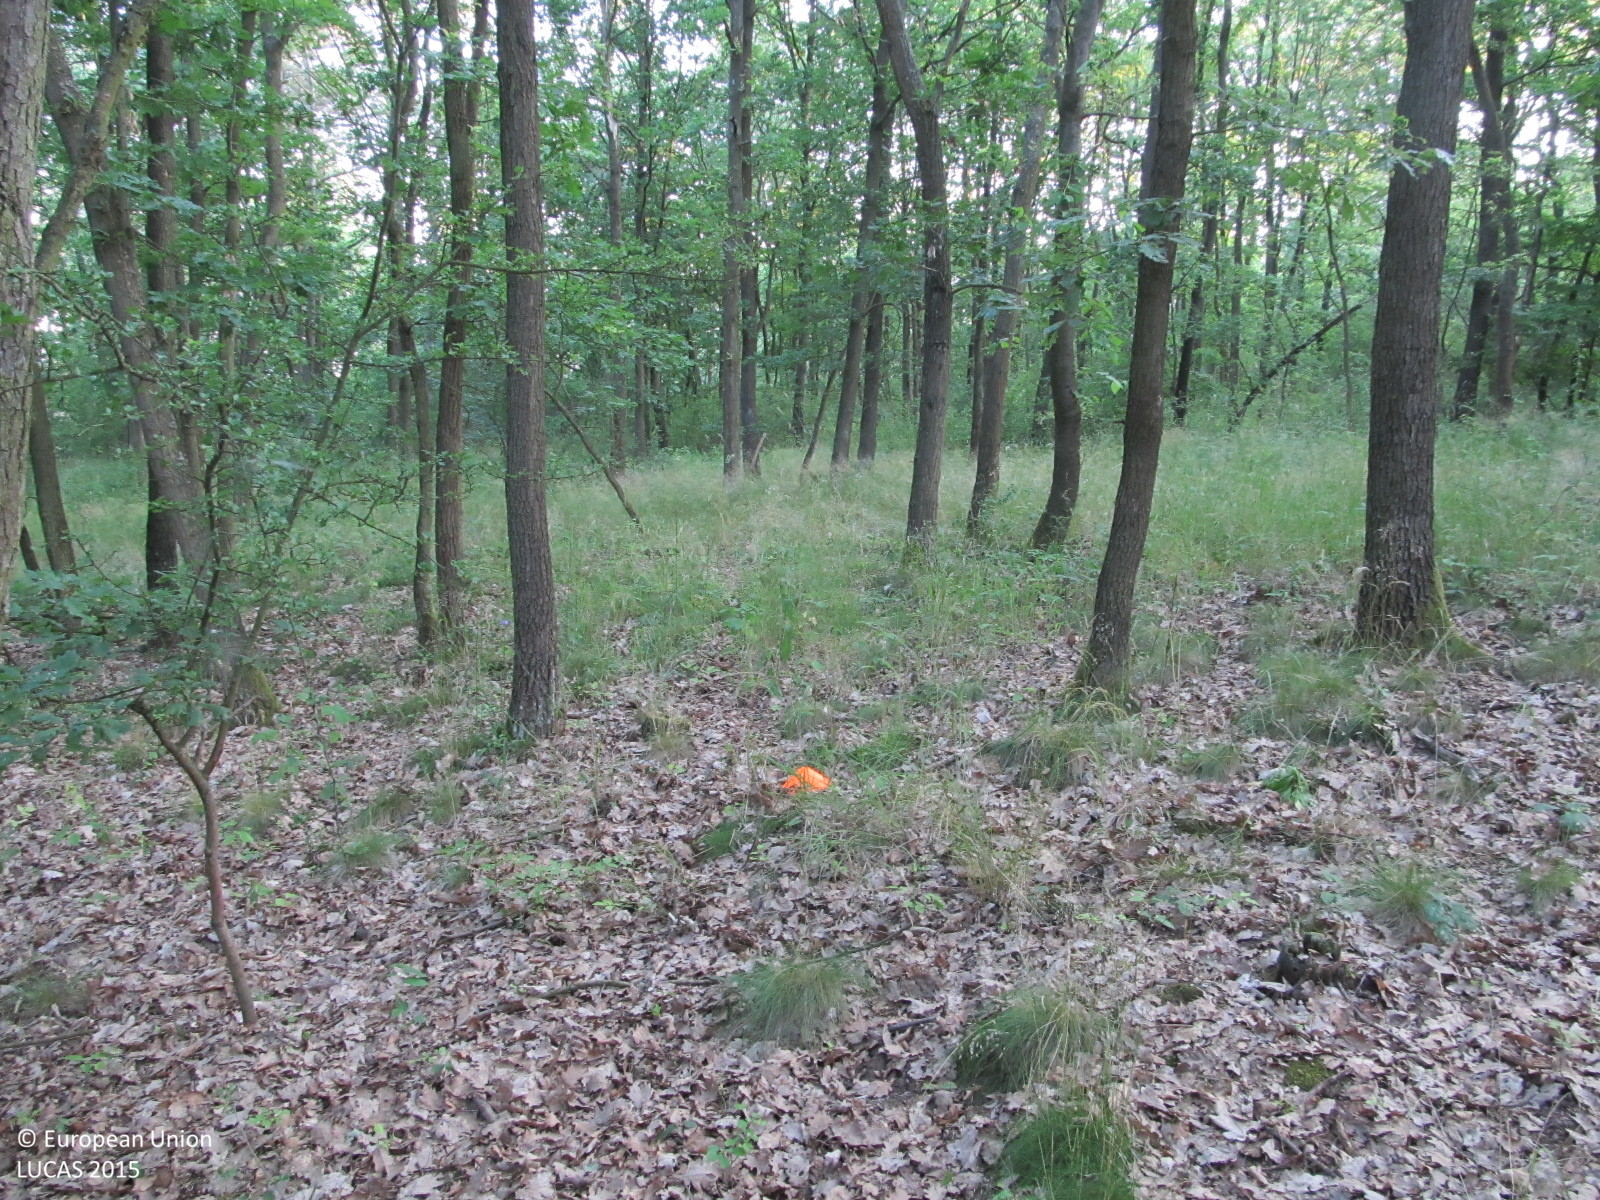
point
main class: Woodland
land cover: Broadleaved woodland
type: mesophytic deciduous forest
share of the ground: > 75 %
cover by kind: broadleaved forest trees 75 %, shrubs 10 %, herbaceous plants 10 %, unconsolidated bare surface 5 %
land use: Forestry
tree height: > 5 m
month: July
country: AT
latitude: 48.7184
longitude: 15.8351
